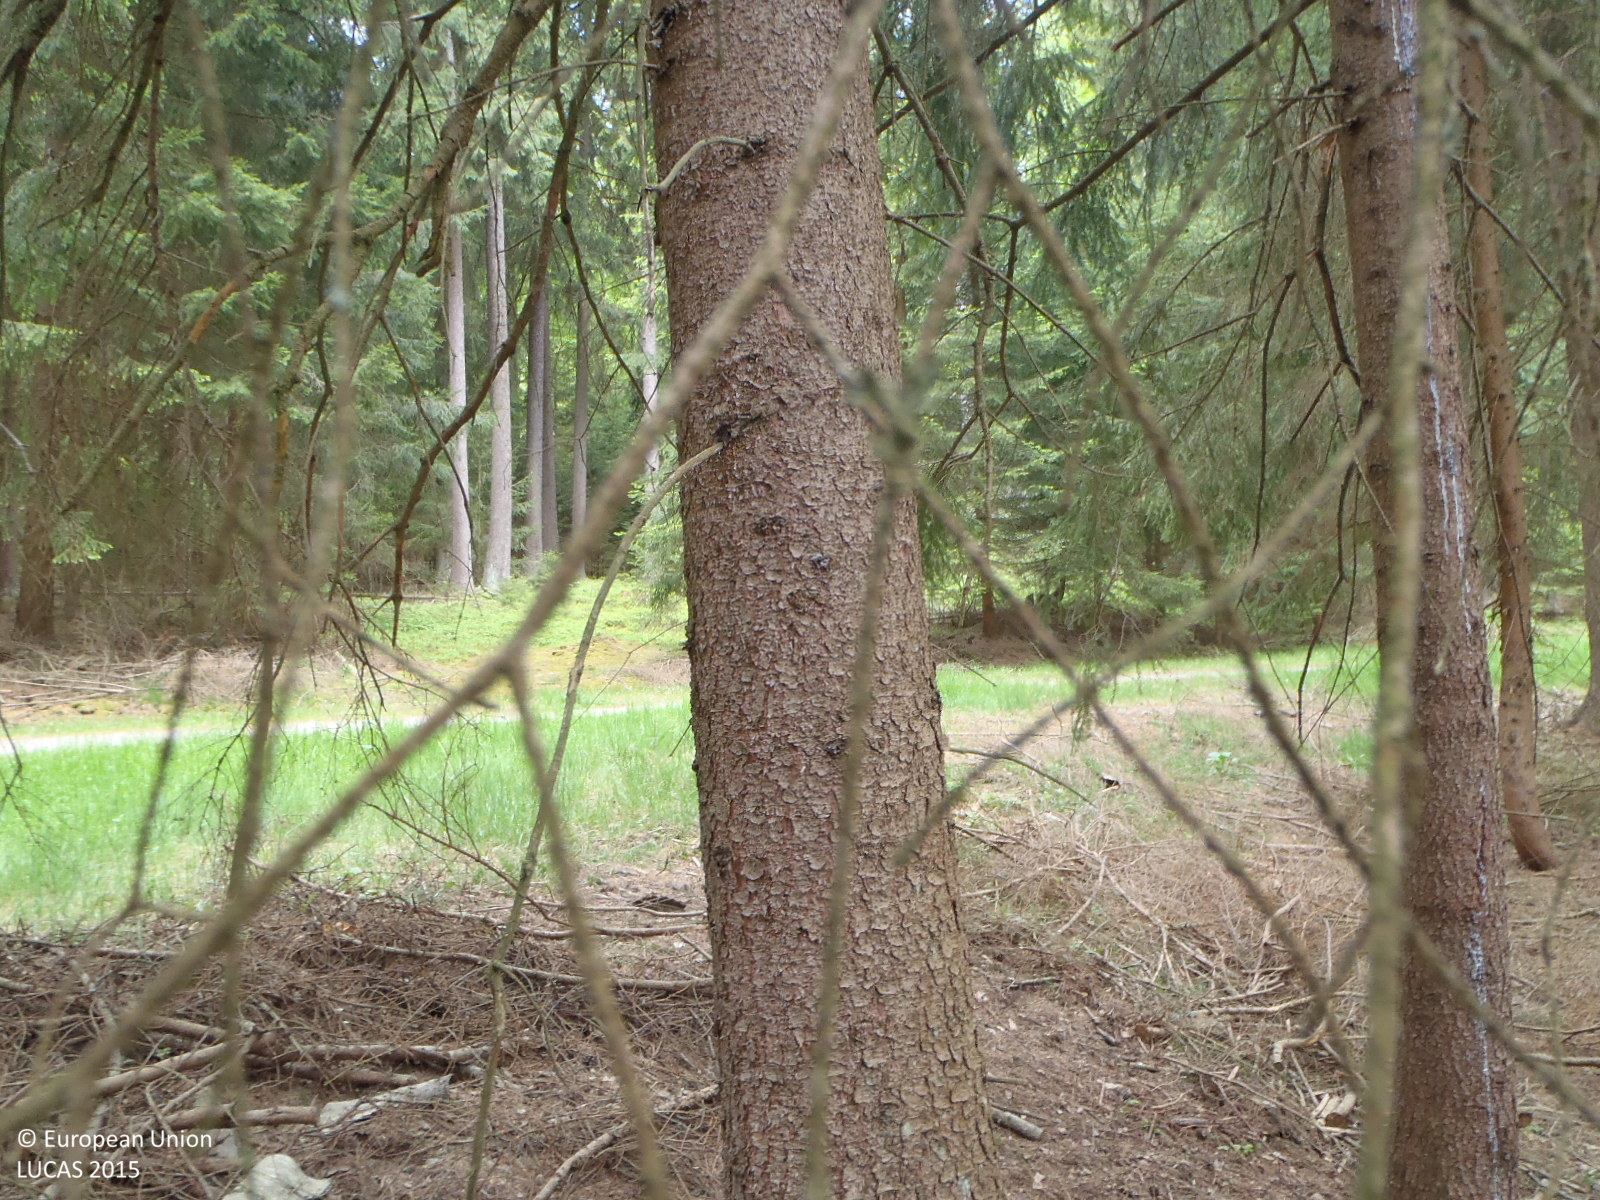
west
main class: Woodland
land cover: Spruce dominated coniferous woodland
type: hemiboreal forest and nemoral coniferous forest and mixed broadleaved-coniferous forest
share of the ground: > 75 %
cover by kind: coniferous forest trees 75 %, herbaceous plants 10 %, unconsolidated bare surface 10 %, broadleaved forest trees 5 %
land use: Forestry
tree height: > 5 m
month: May
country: CZ
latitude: 49.0798
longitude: 15.0816
